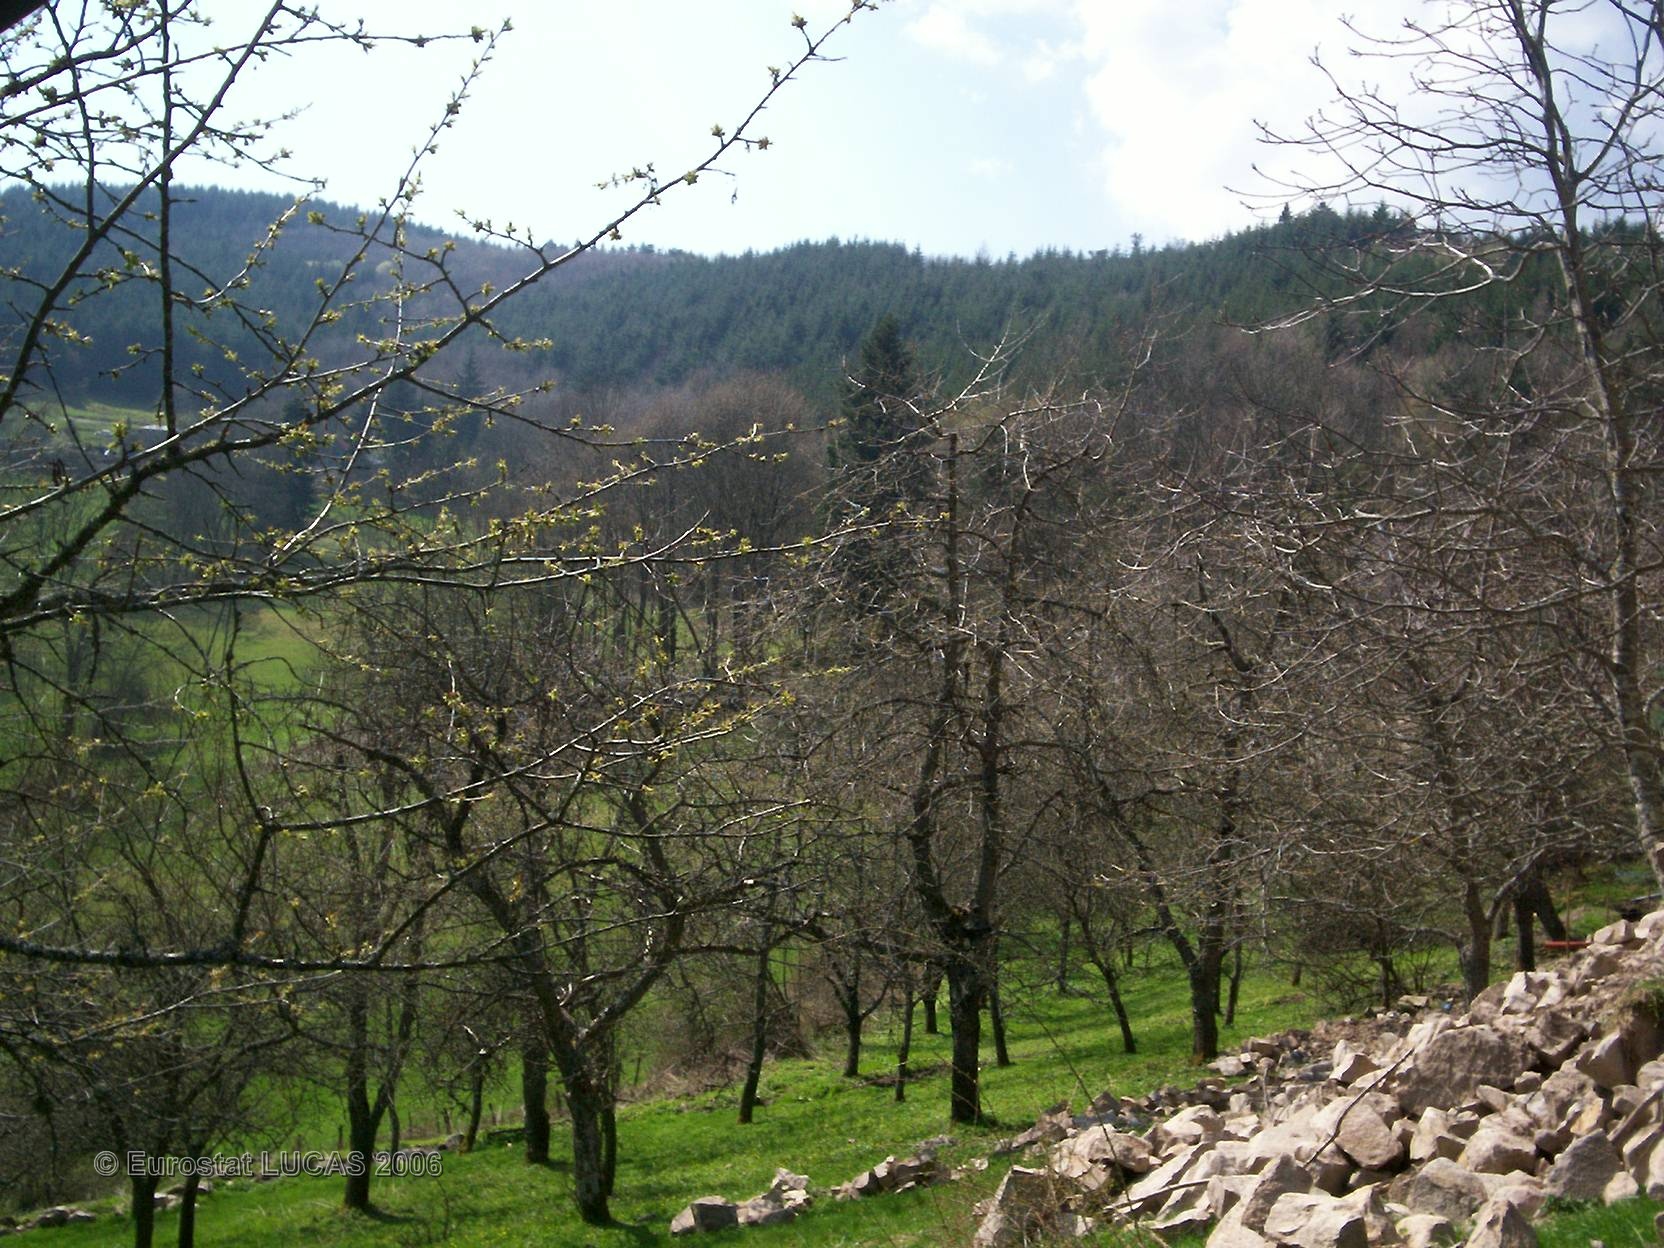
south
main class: Cropland
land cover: Other fruit trees and berries
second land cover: Grassland with sparse tree/shrub cover
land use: Kitchen garden
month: April
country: FR
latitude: 48.0238
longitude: 7.1183
